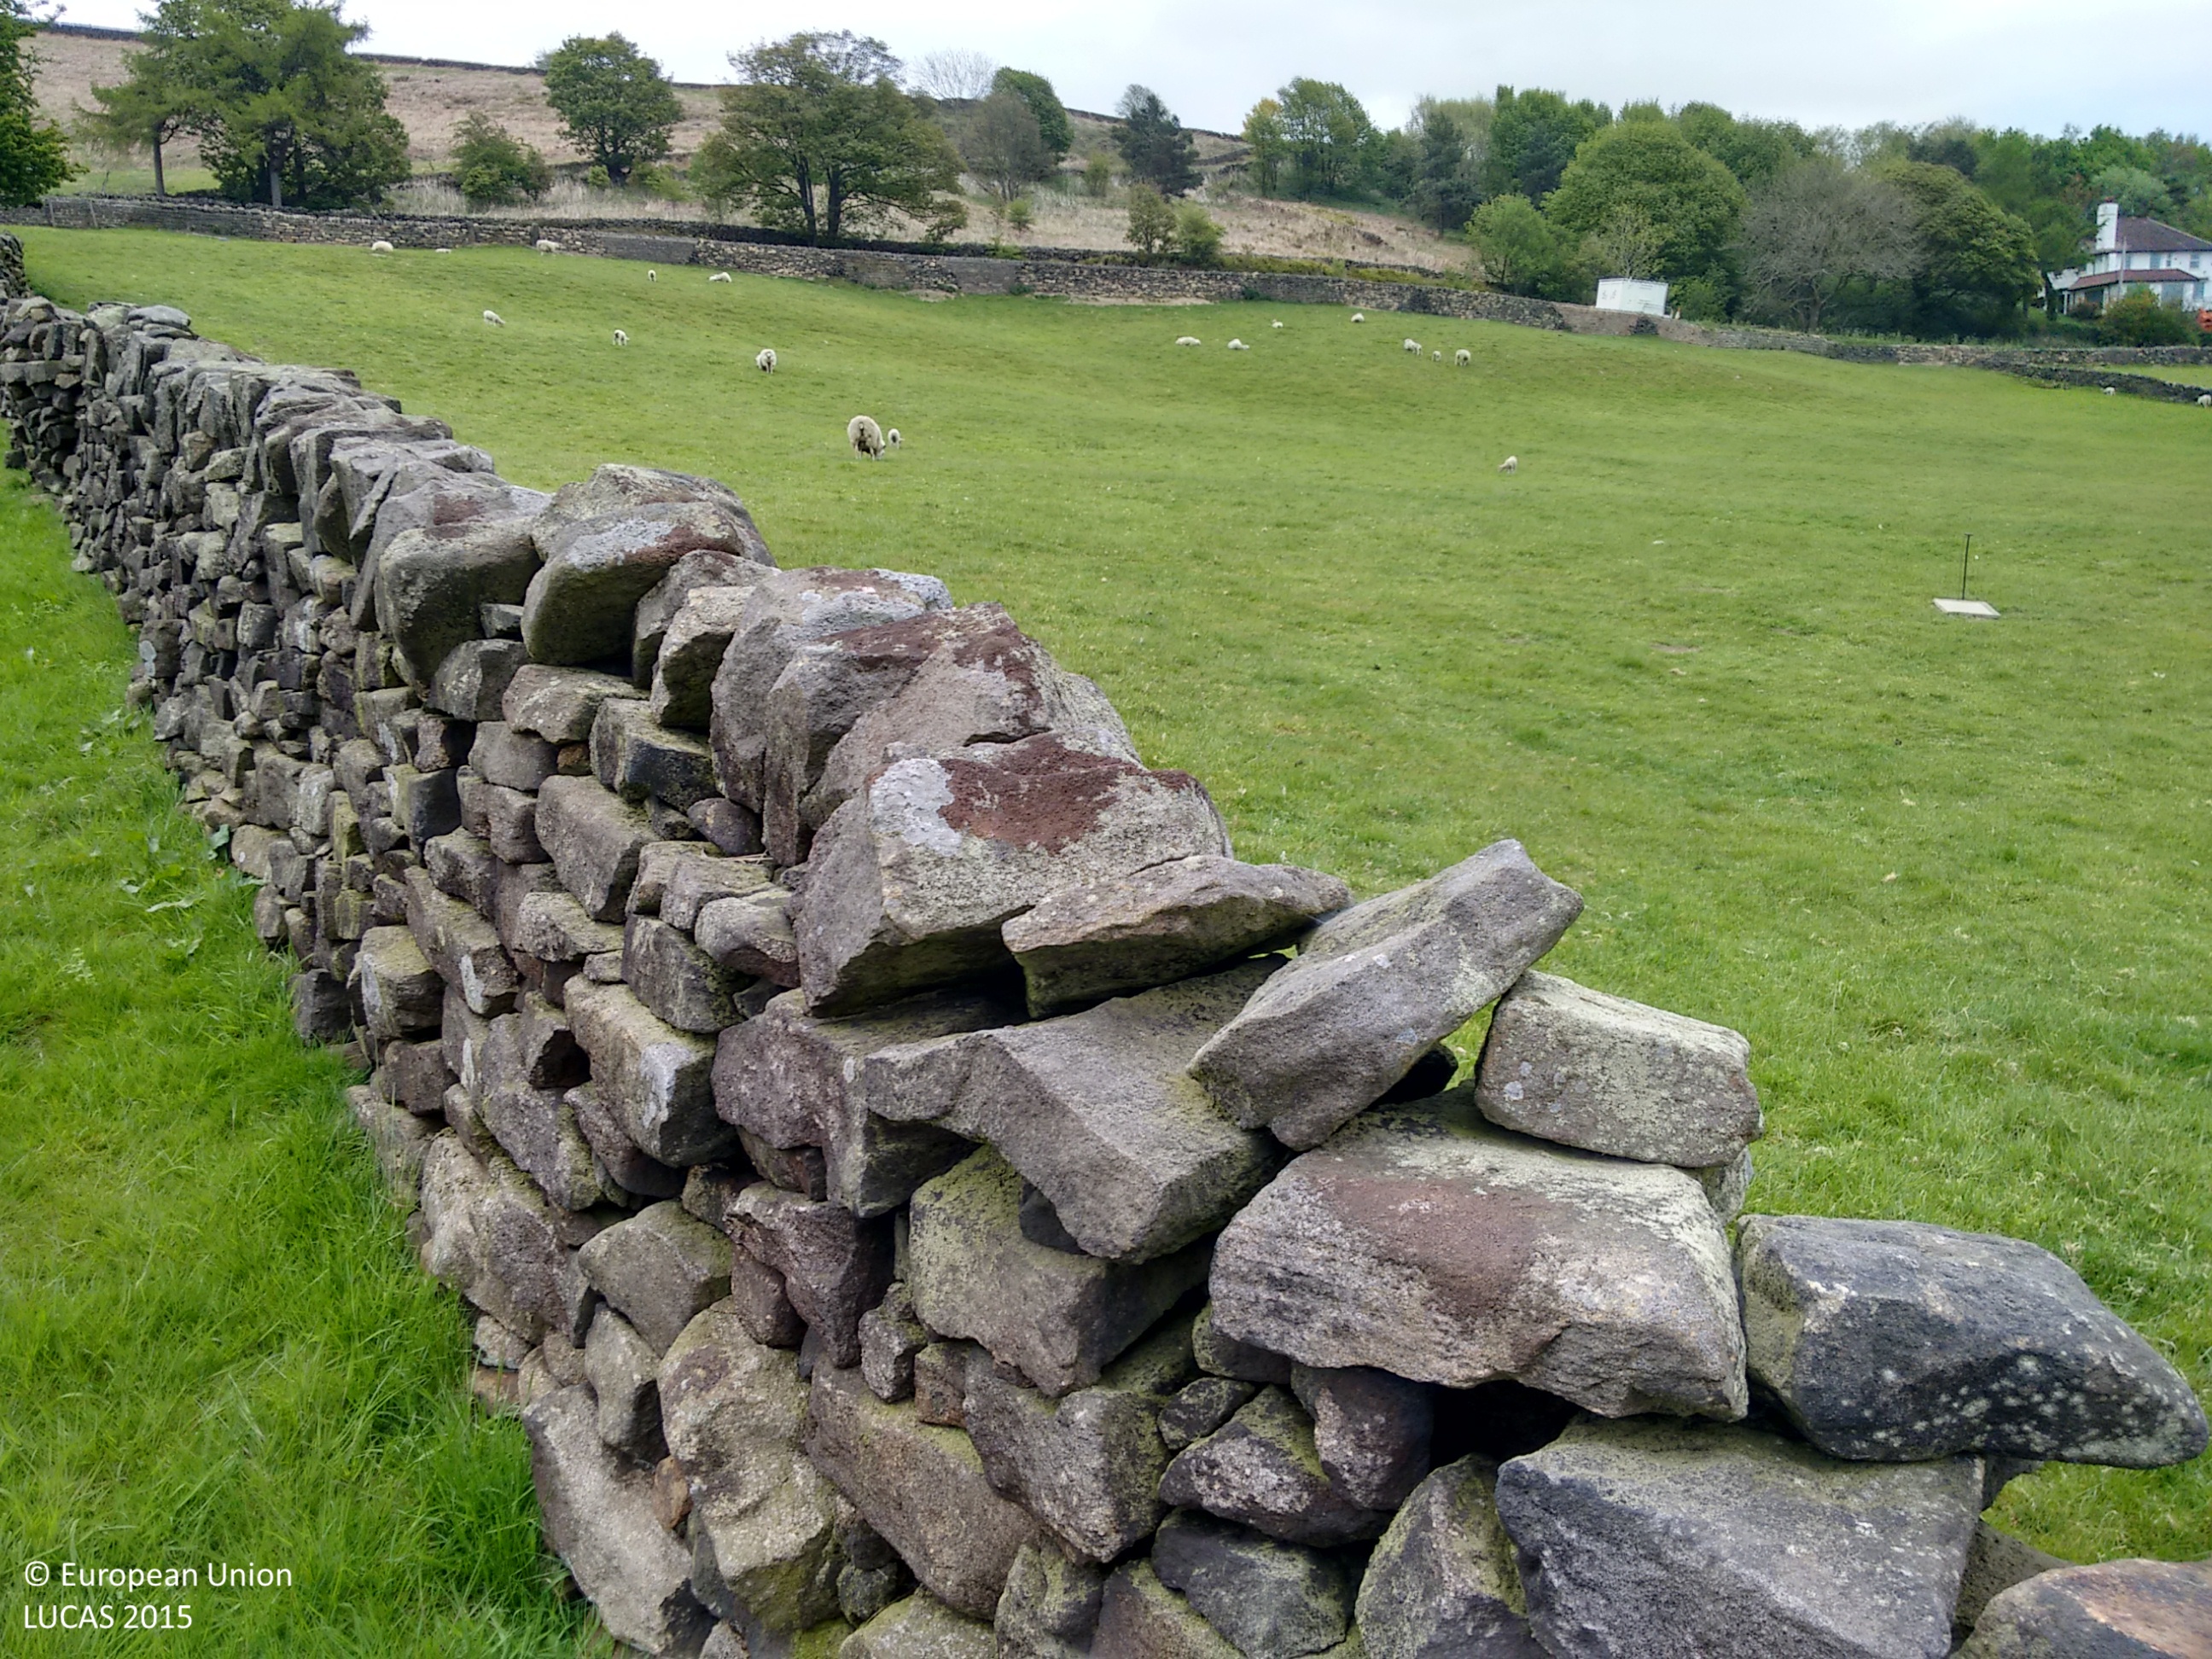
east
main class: Grassland
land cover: Grassland without tree/shrub cover
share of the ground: > 75 %
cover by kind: herbaceous plants 100 %
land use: Agriculture (excluding fallow land and kitchen gardens)
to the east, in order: Grassland without tree/shrub cover; Dry stone walls; Grassland without tree/shrub cover; Dry stone walls; Grassland without tree/shrub cover; Dry stone walls; Grass margins; Paved roads, cycling and walking lanes; Grass margins; Dry stone walls; Broadleaved woodland; Artificial constructions in urban areas; Broadleaved woodland
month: May
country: GB
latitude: 53.4243
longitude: -1.5938
